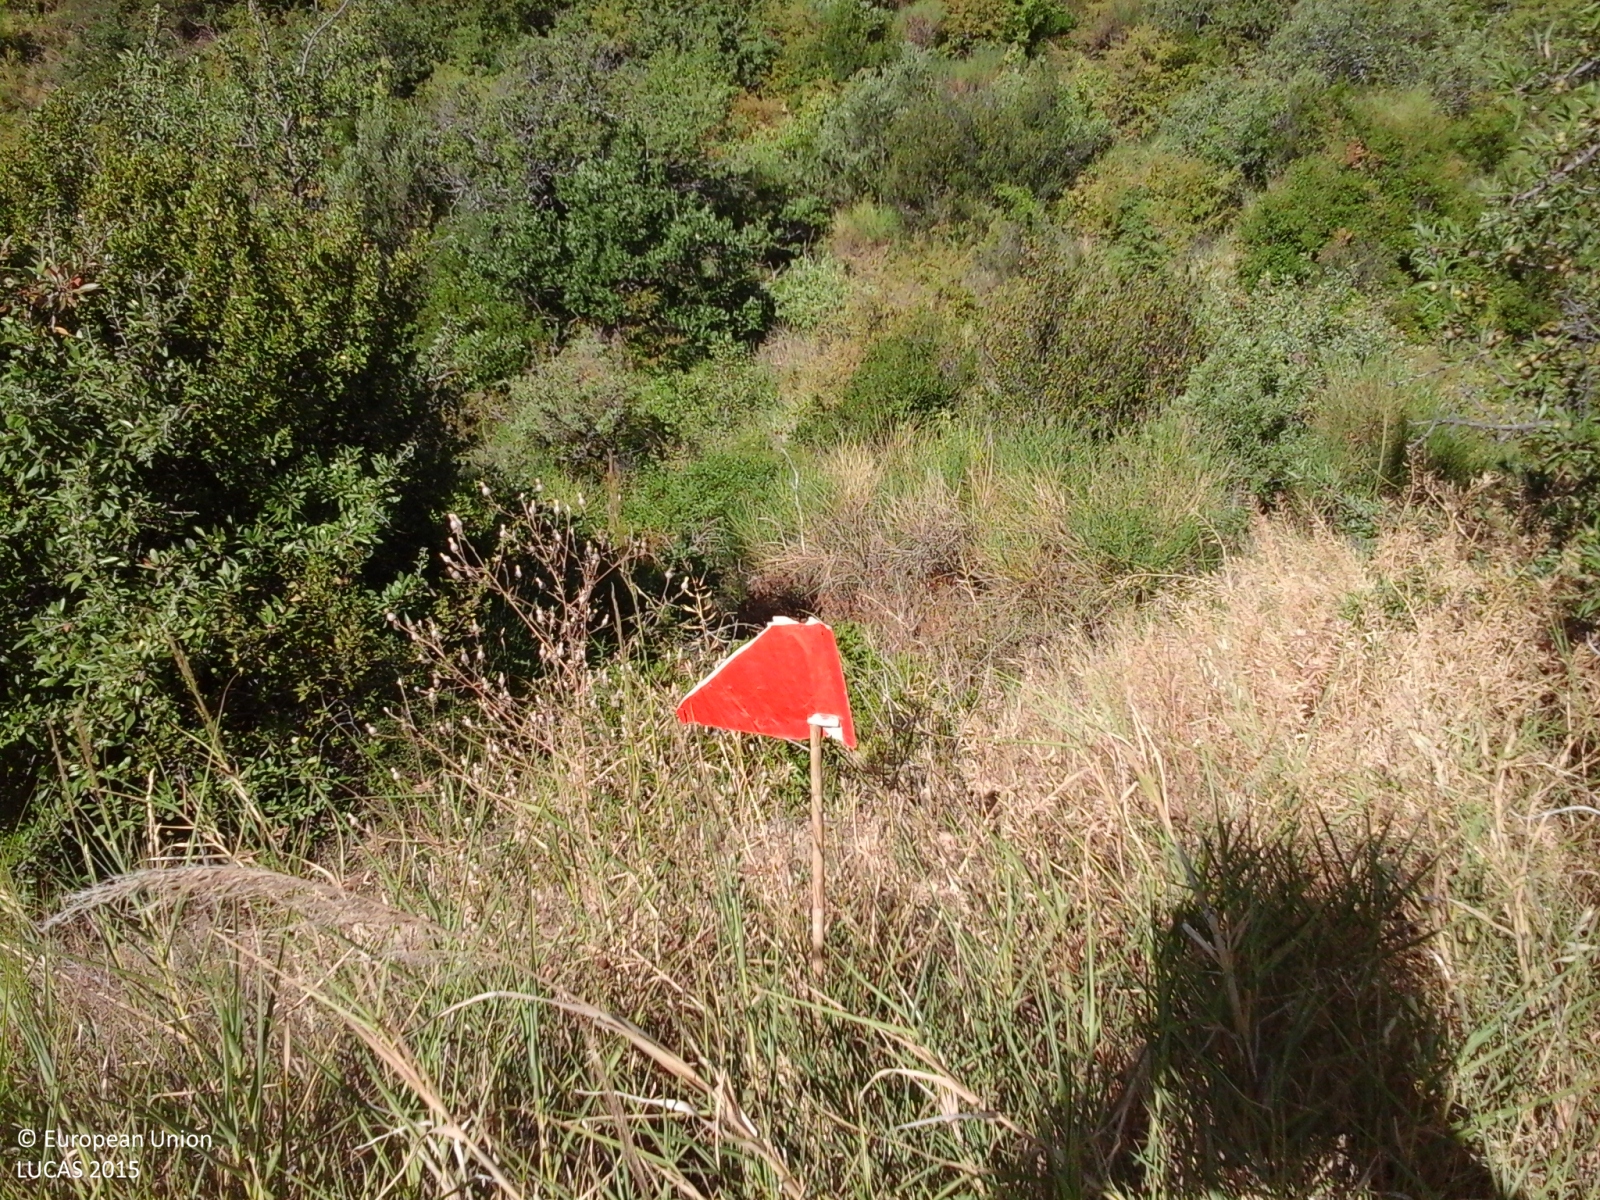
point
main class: Shrubland
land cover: Shrubland with sparse tree cover
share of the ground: > 75 %
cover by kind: shrubs 95 %, broadleaved forest trees 5 %
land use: Semi-natural and natural areas not in use
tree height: < 5 m
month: July
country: IT
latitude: 41.8688
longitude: 14.8399
